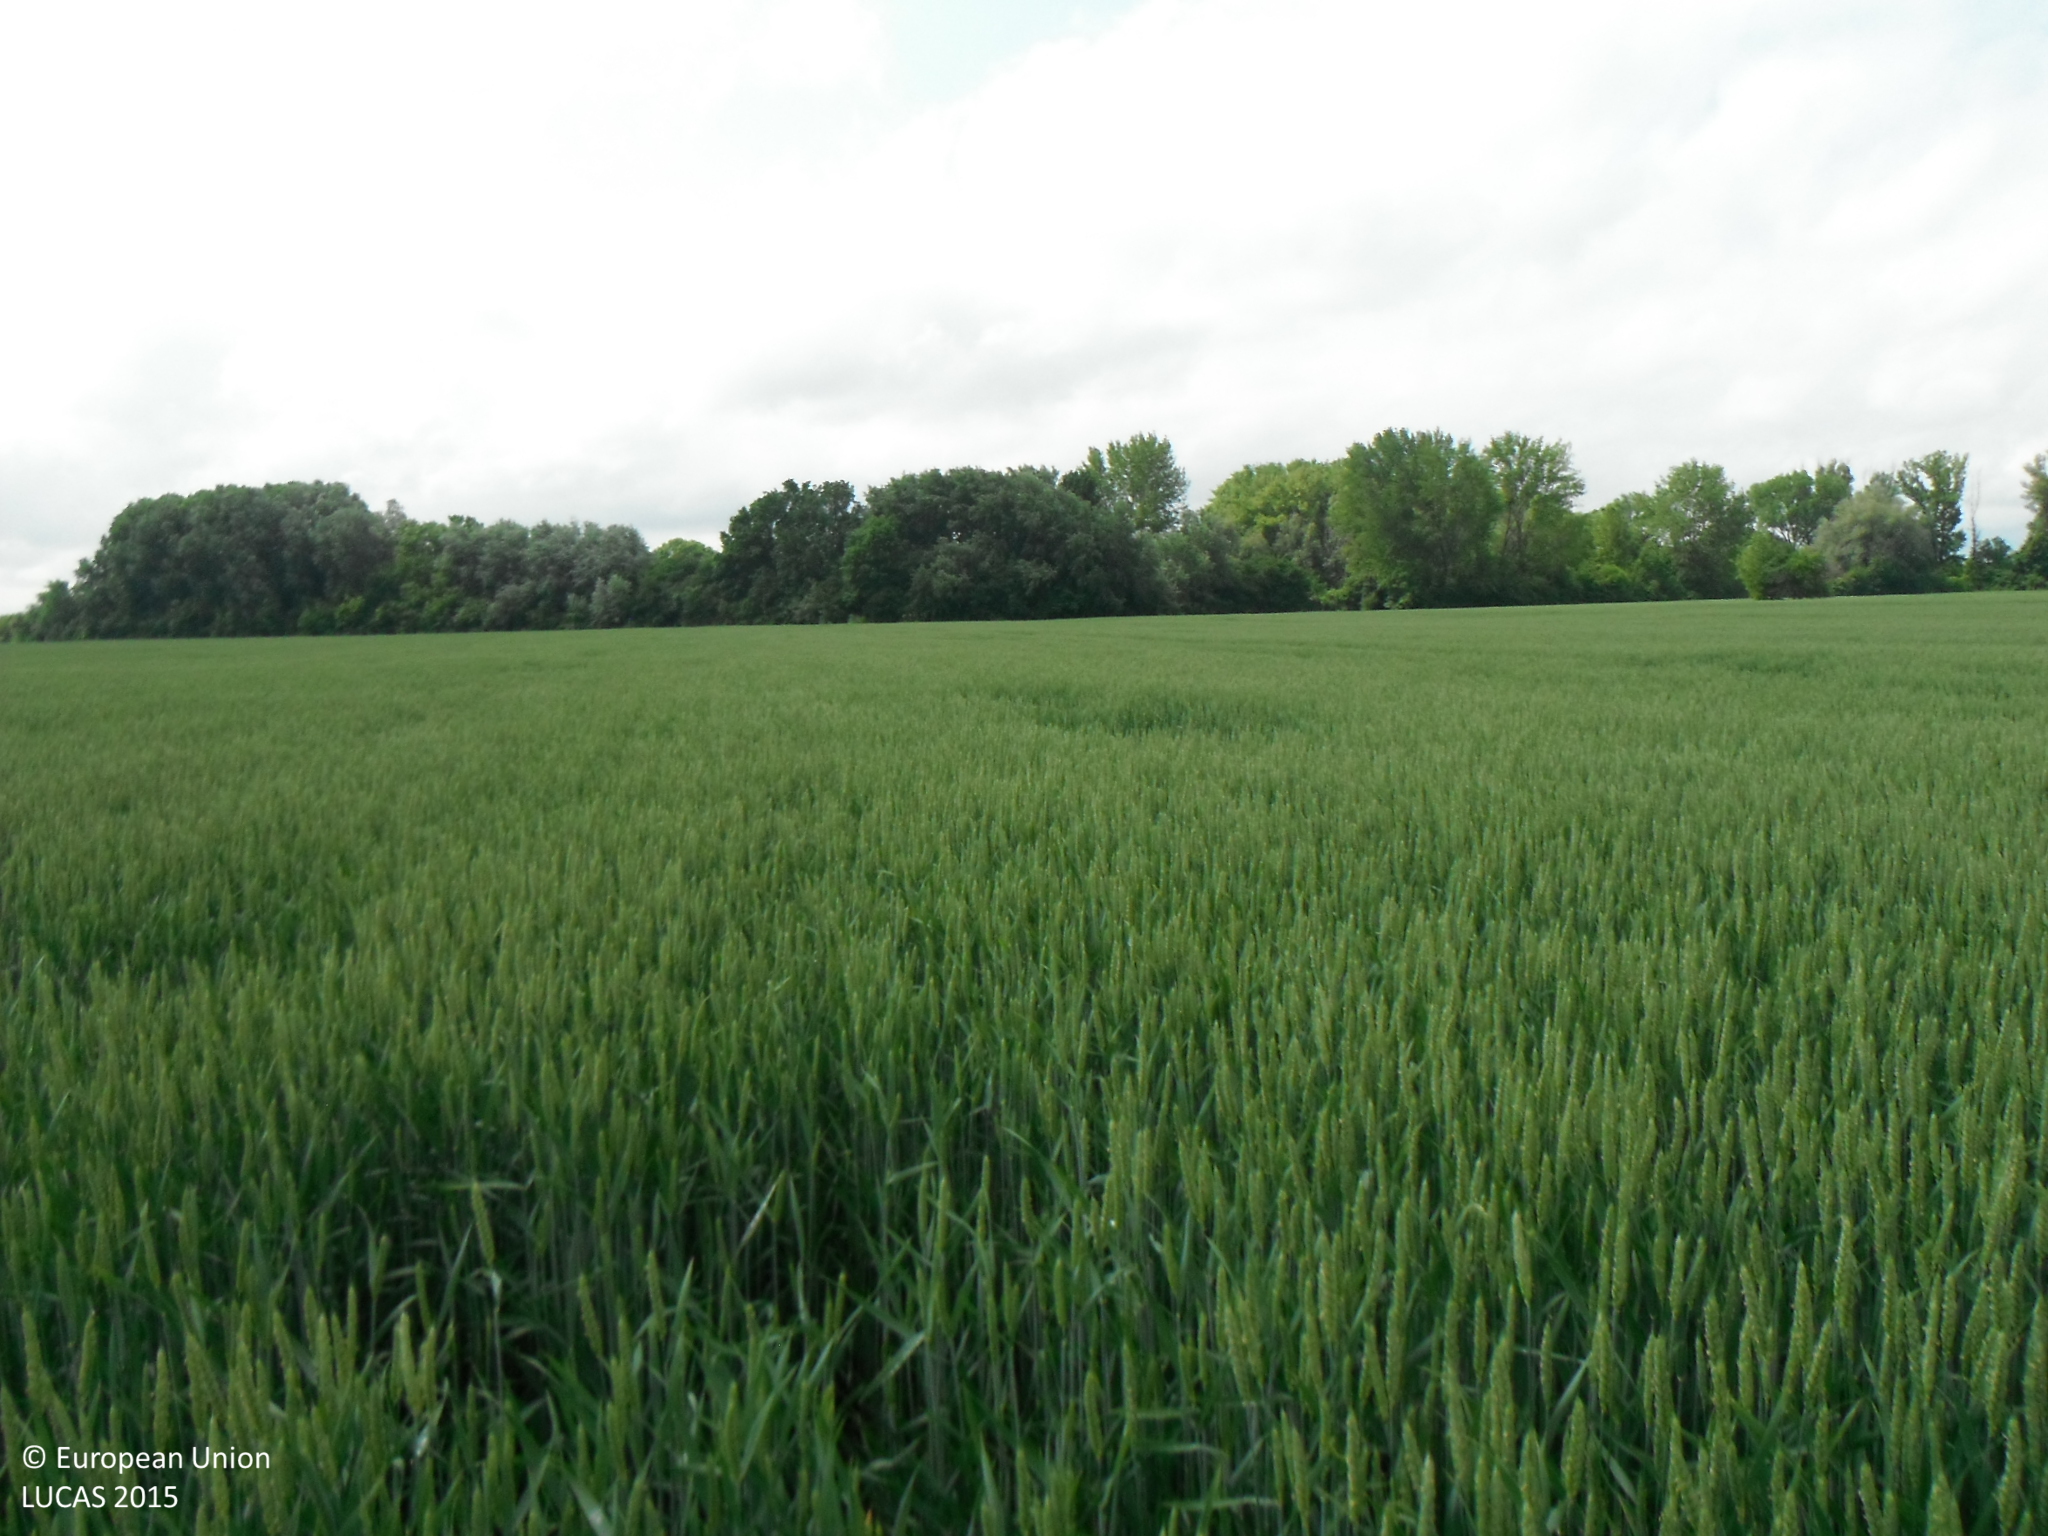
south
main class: Cropland
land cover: Common wheat
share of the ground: > 75 %
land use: Agriculture (excluding fallow land and kitchen gardens)
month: May
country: SK
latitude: 48.1528
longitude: 18.2003
